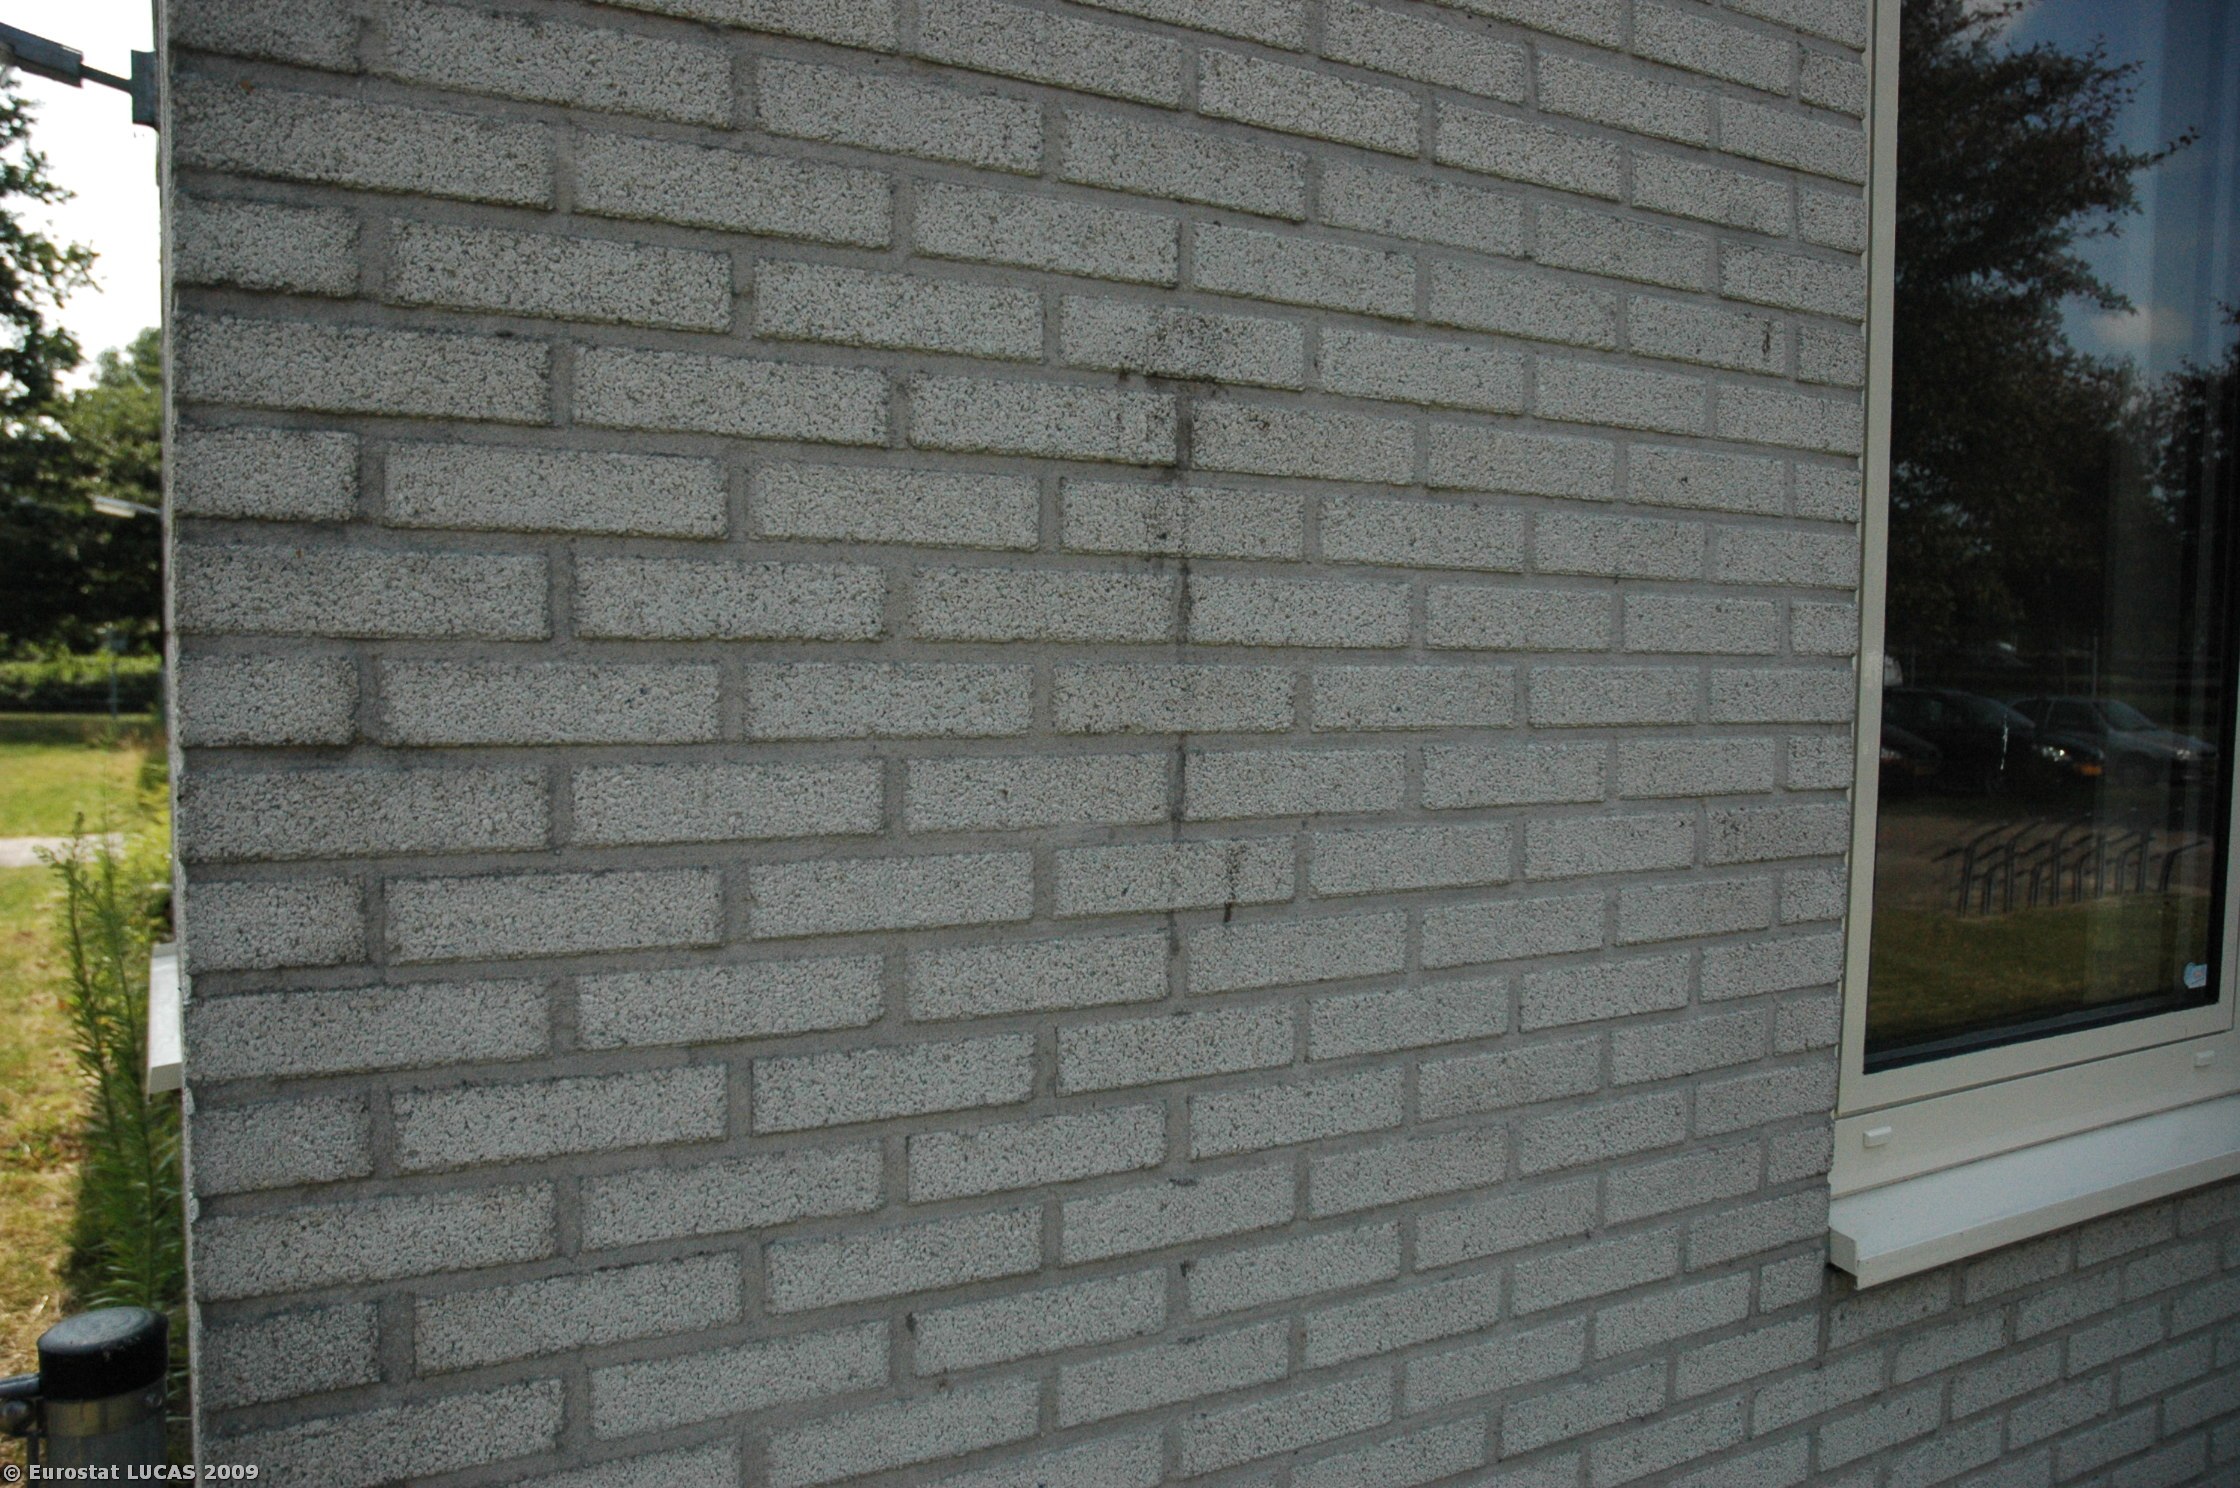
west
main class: Grassland
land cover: Grassland without tree/shrub cover
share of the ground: > 75 %
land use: Residential
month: June
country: NL
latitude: 52.3918
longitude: 5.2810
